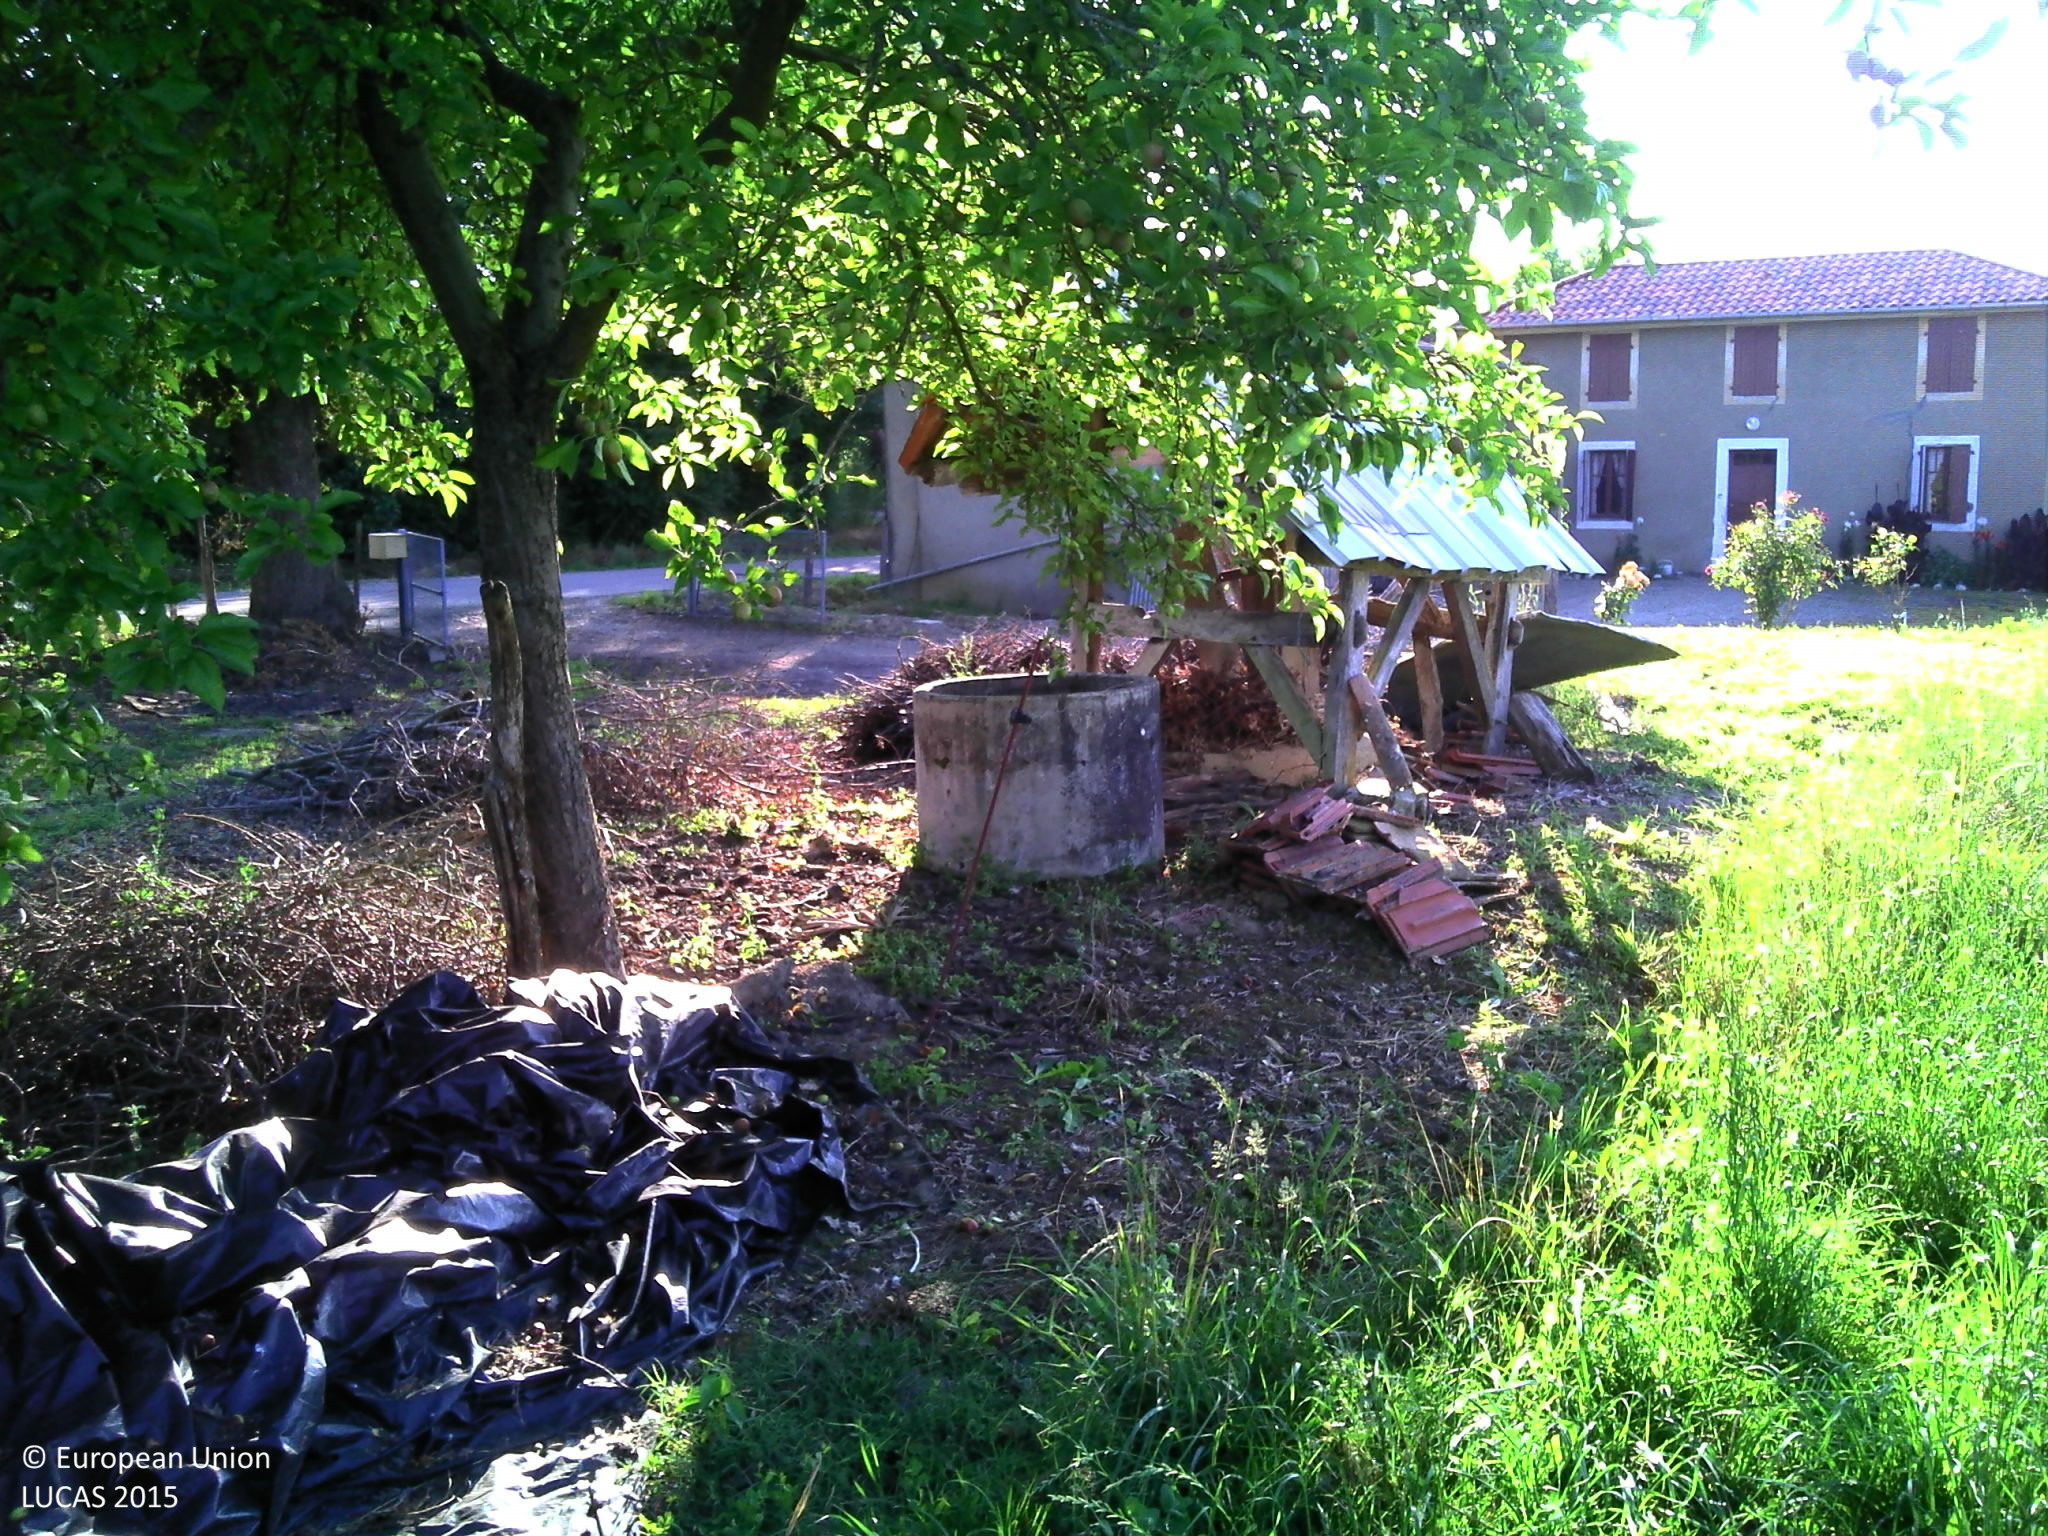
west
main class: Grassland
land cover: Grassland without tree/shrub cover
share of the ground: > 75 %
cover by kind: herbaceous plants 100 %
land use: Agriculture (excluding fallow land and kitchen gardens)
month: June
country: FR
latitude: 43.5877
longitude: -0.4254
